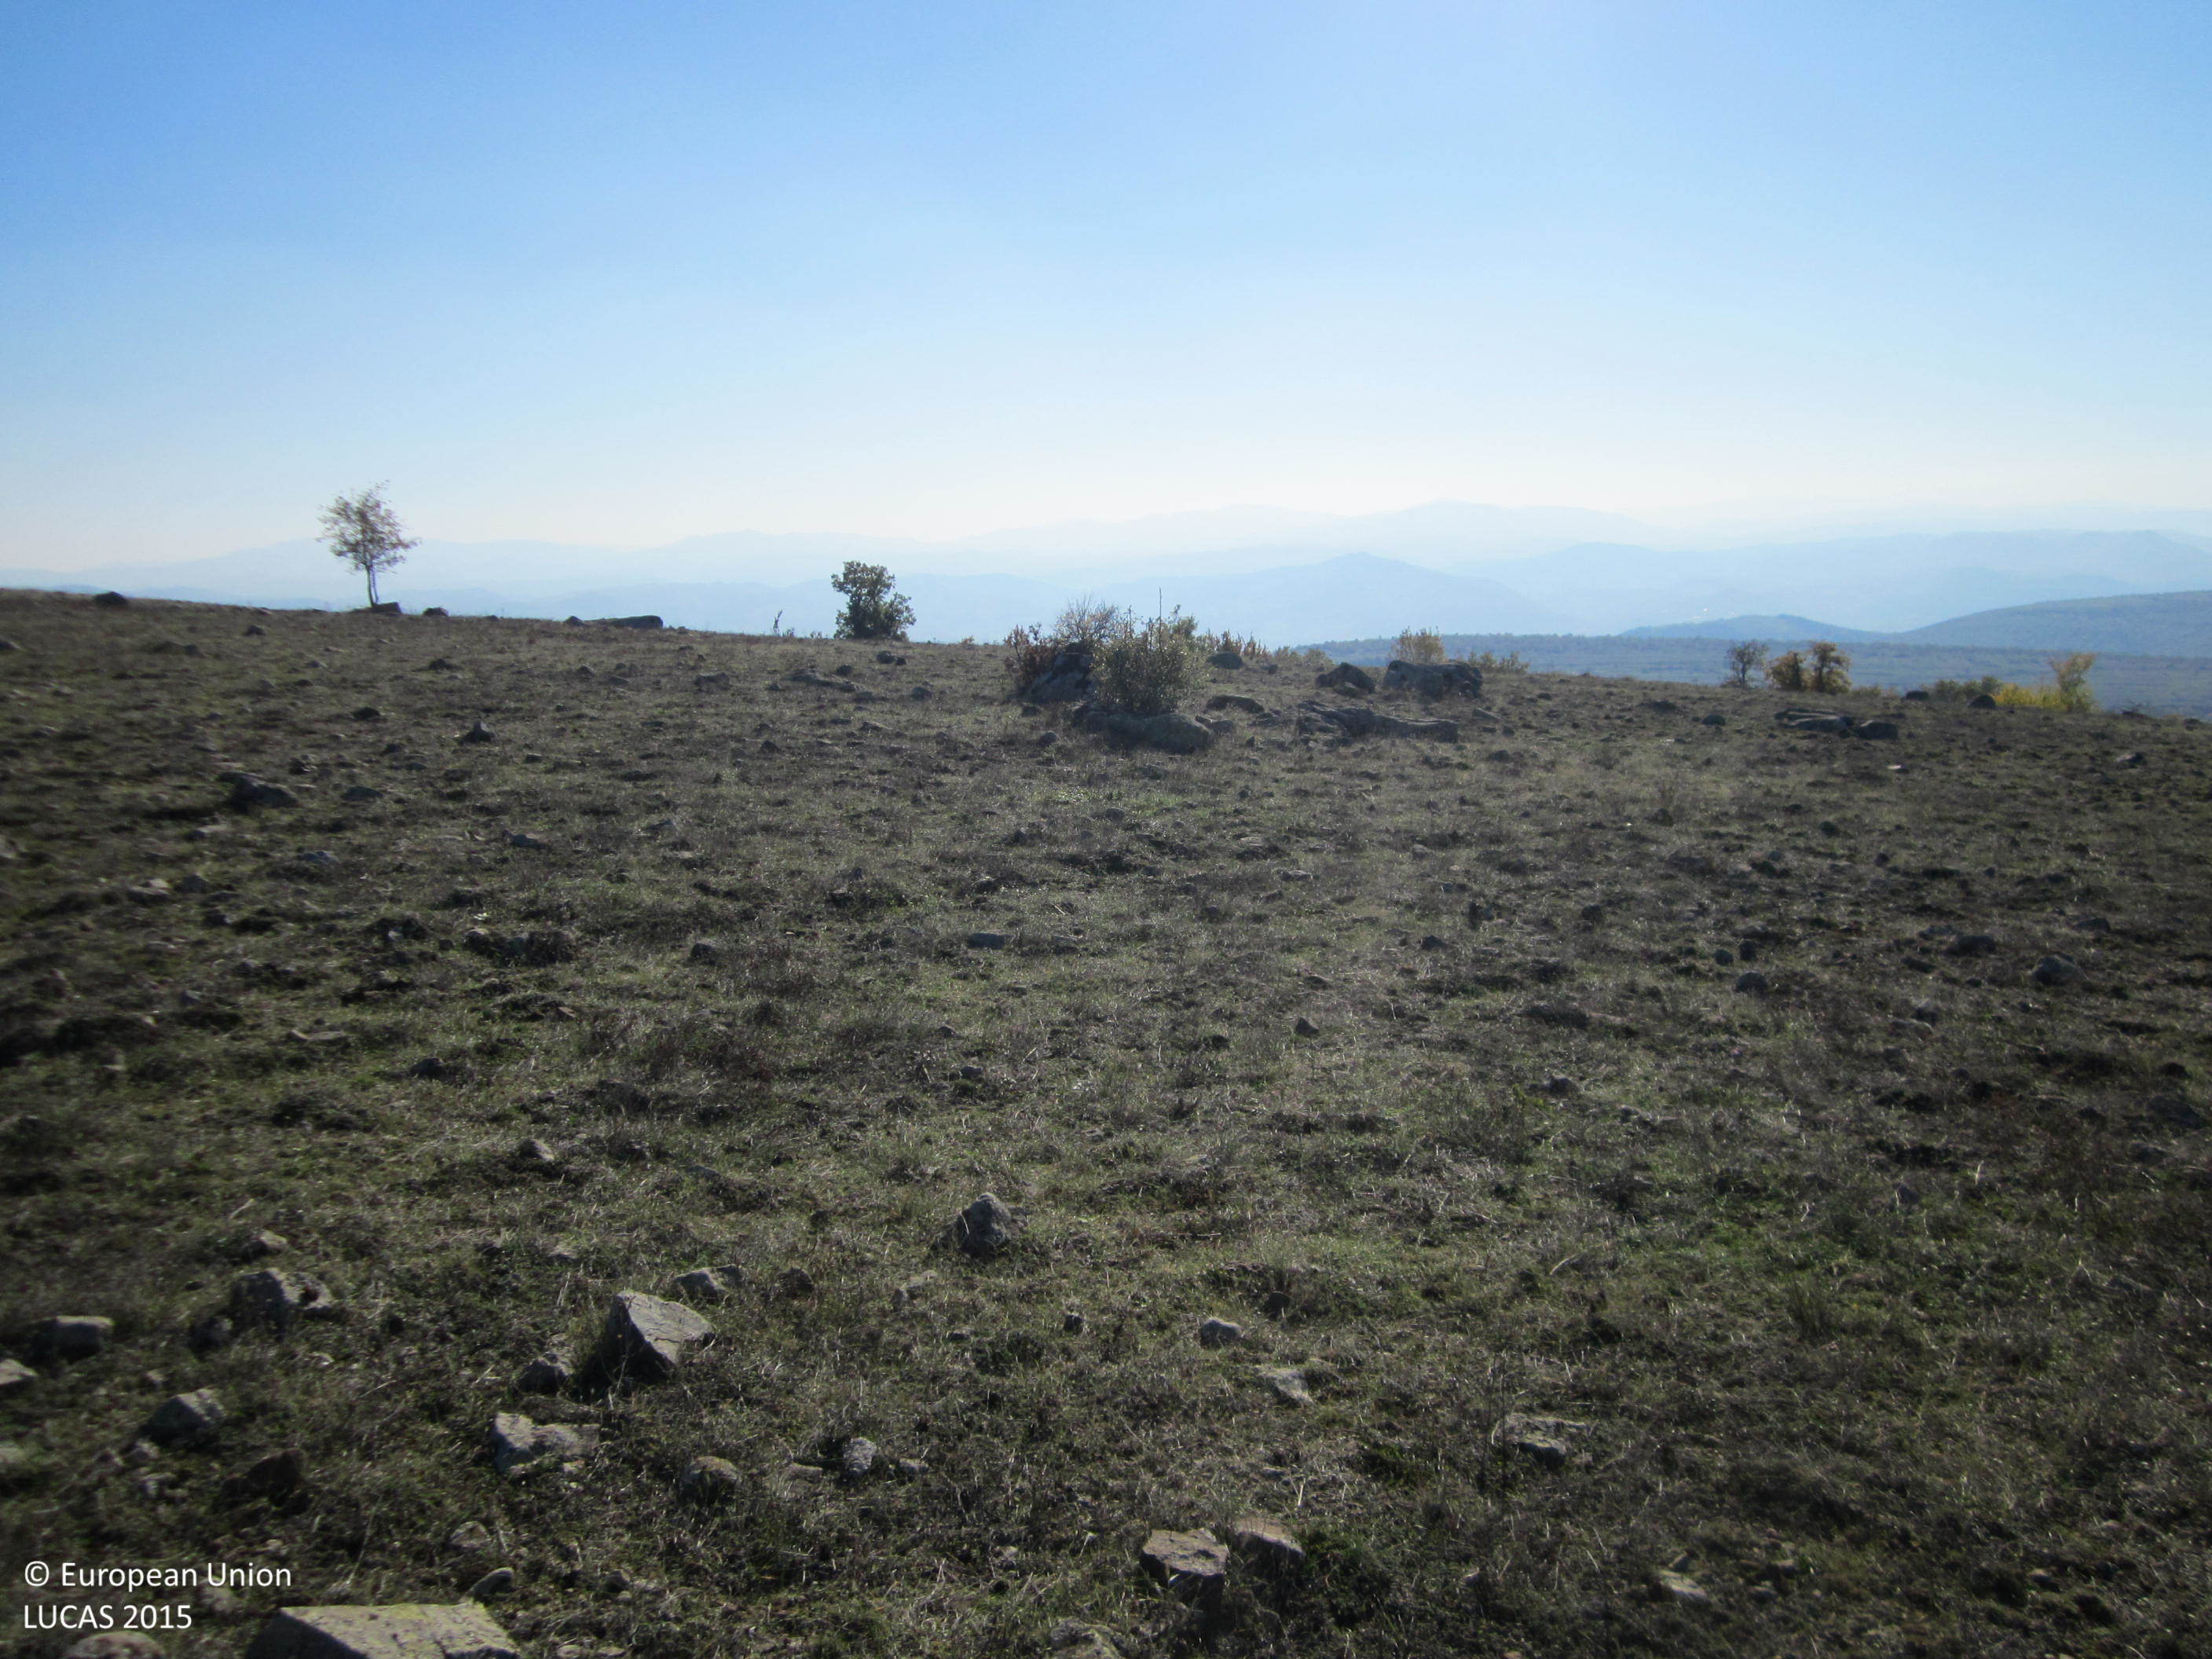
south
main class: Grassland
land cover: Grassland without tree/shrub cover
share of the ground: > 75 %
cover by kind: herbaceous plants 80 %, unconsolidated bare surface 20 %
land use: Agriculture (excluding fallow land and kitchen gardens)
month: November
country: BG
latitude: 41.4953
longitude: 25.6934
